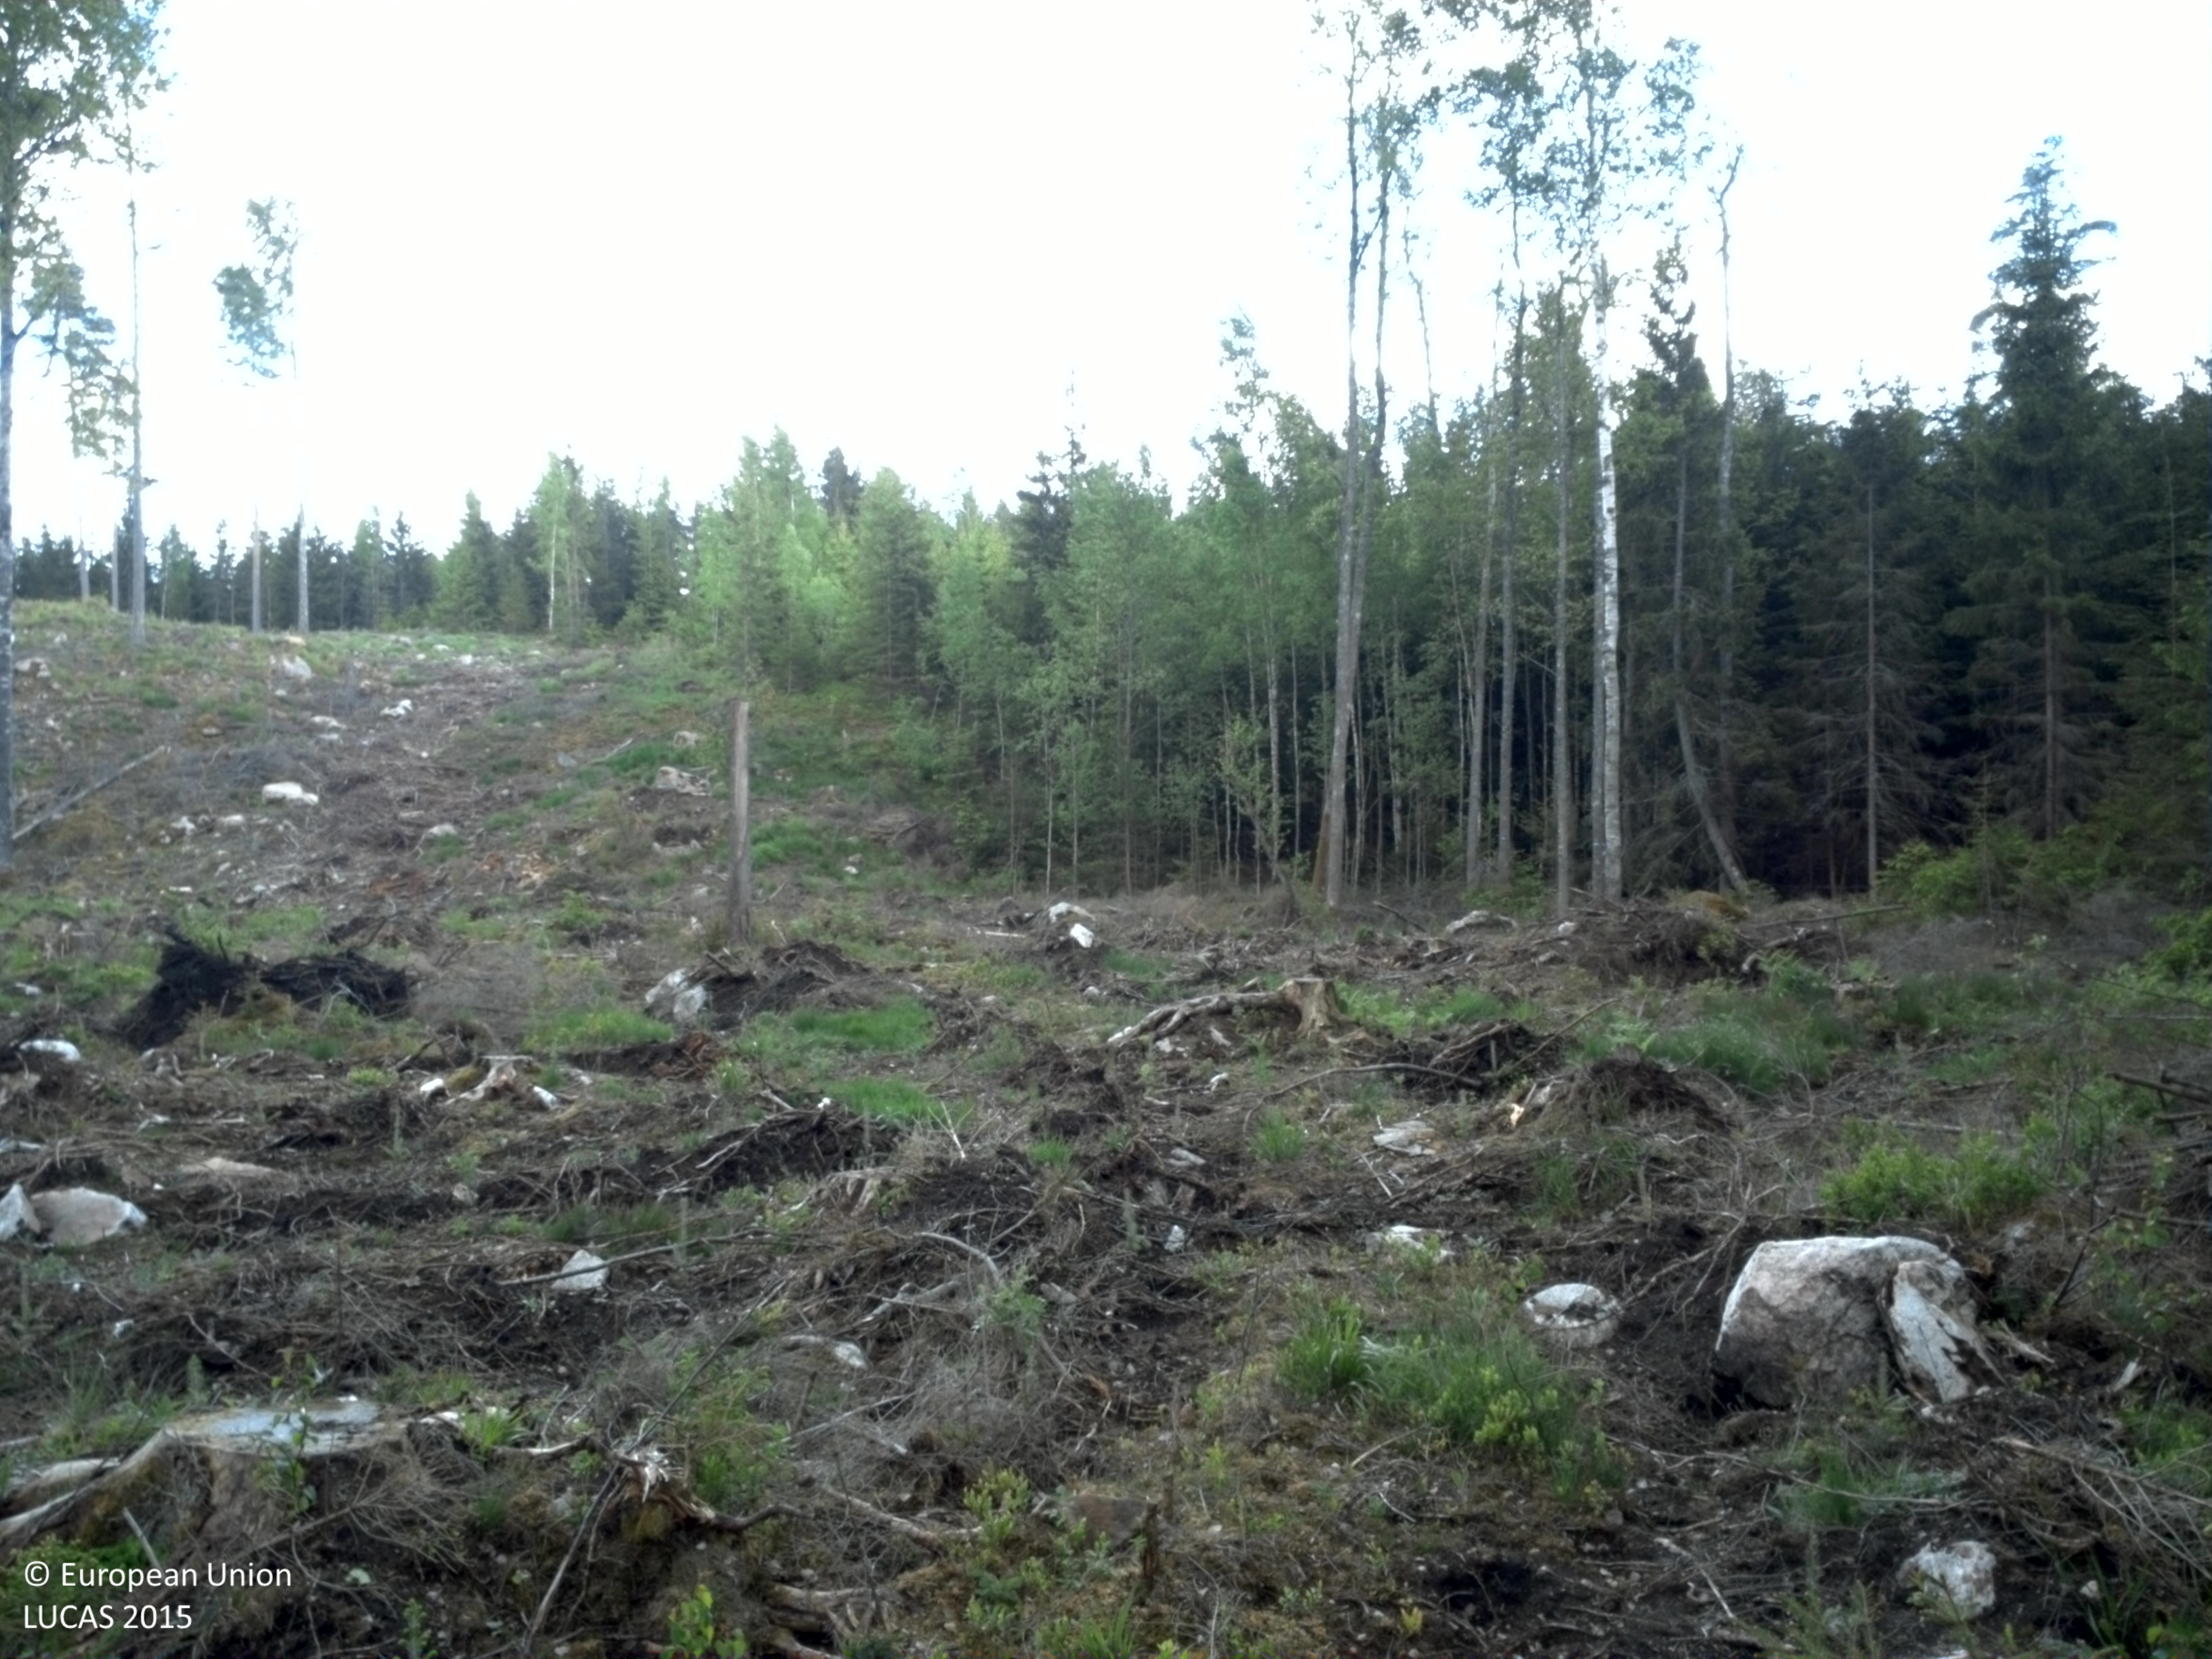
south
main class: Woodland
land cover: Spruce dominated coniferous woodland
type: boreal forest
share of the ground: 10 - 25 %
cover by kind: lichens and mosses 35 %, shrubs 25 %, coniferous forest trees 20 %, herbaceous plants 10 %, broadleaved forest trees 5 %, unconsolidated bare surface 5 %
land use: Forestry
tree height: > 5 m
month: May
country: SE
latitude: 57.2818
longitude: 15.8205
